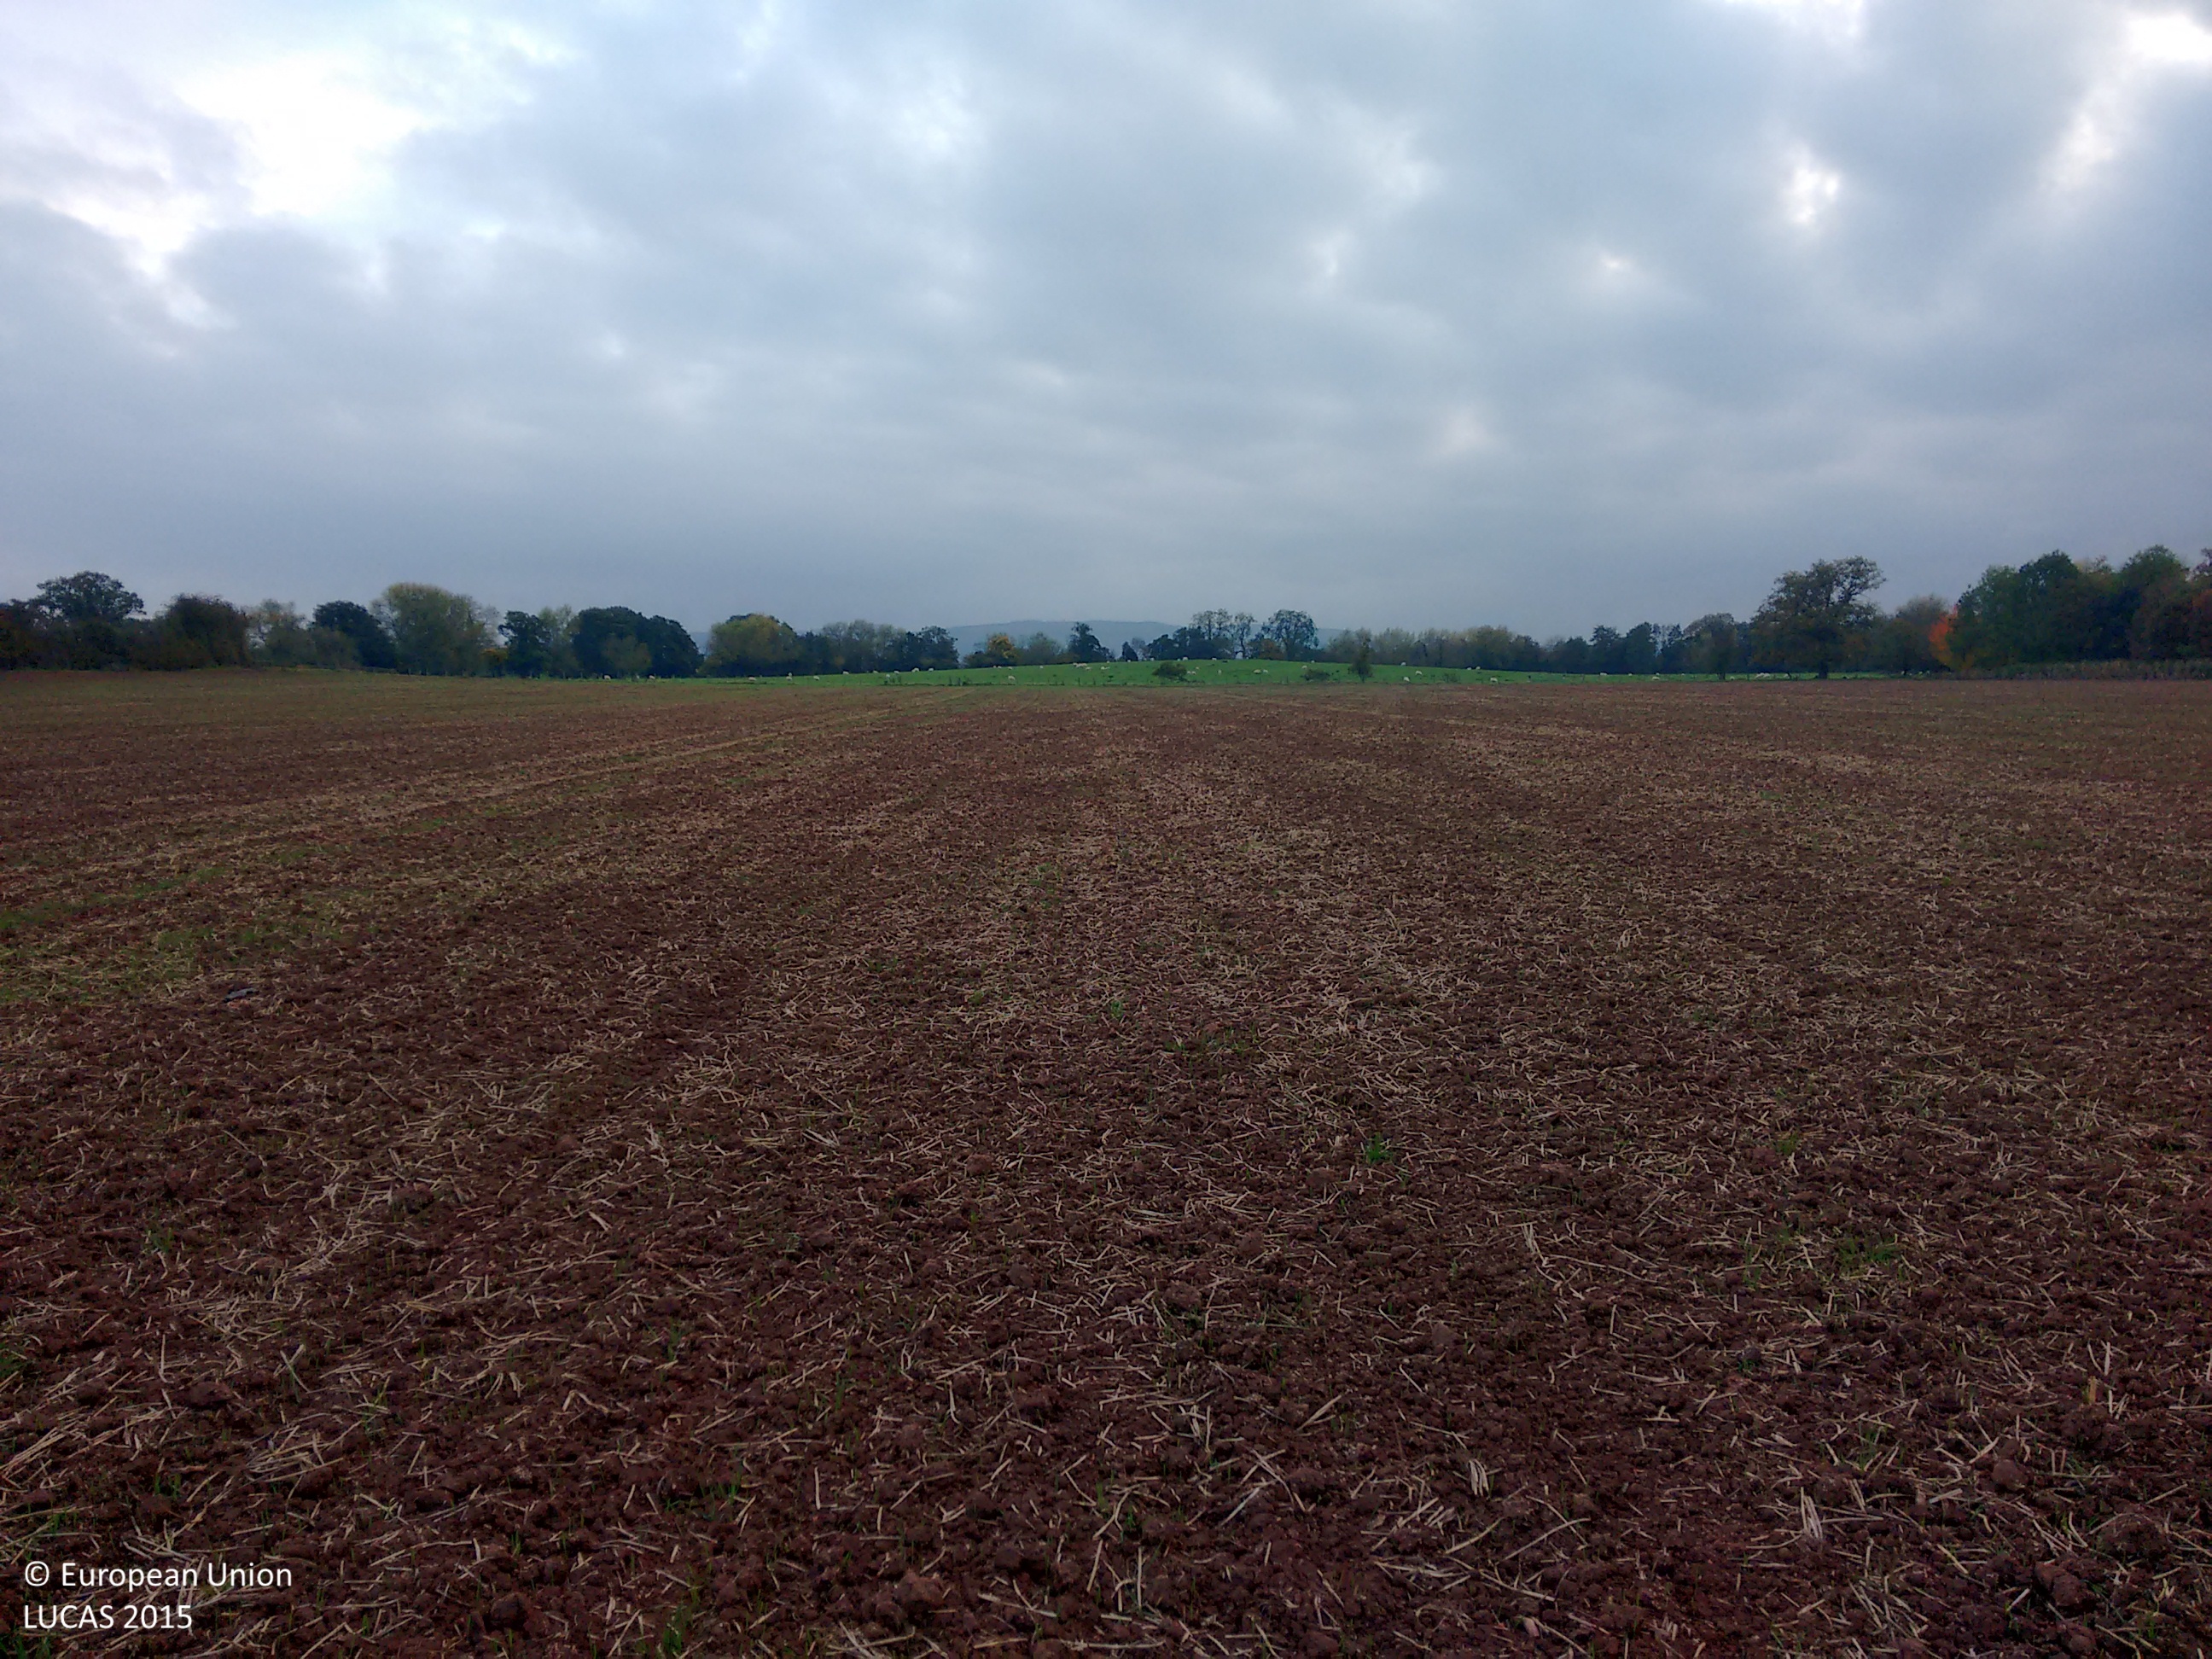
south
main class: Cropland
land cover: Oats
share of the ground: < 10 %
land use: Agriculture (excluding fallow land and kitchen gardens)
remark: Tilled/Sowed
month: October
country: GB
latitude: 52.4347
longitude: -2.7347
